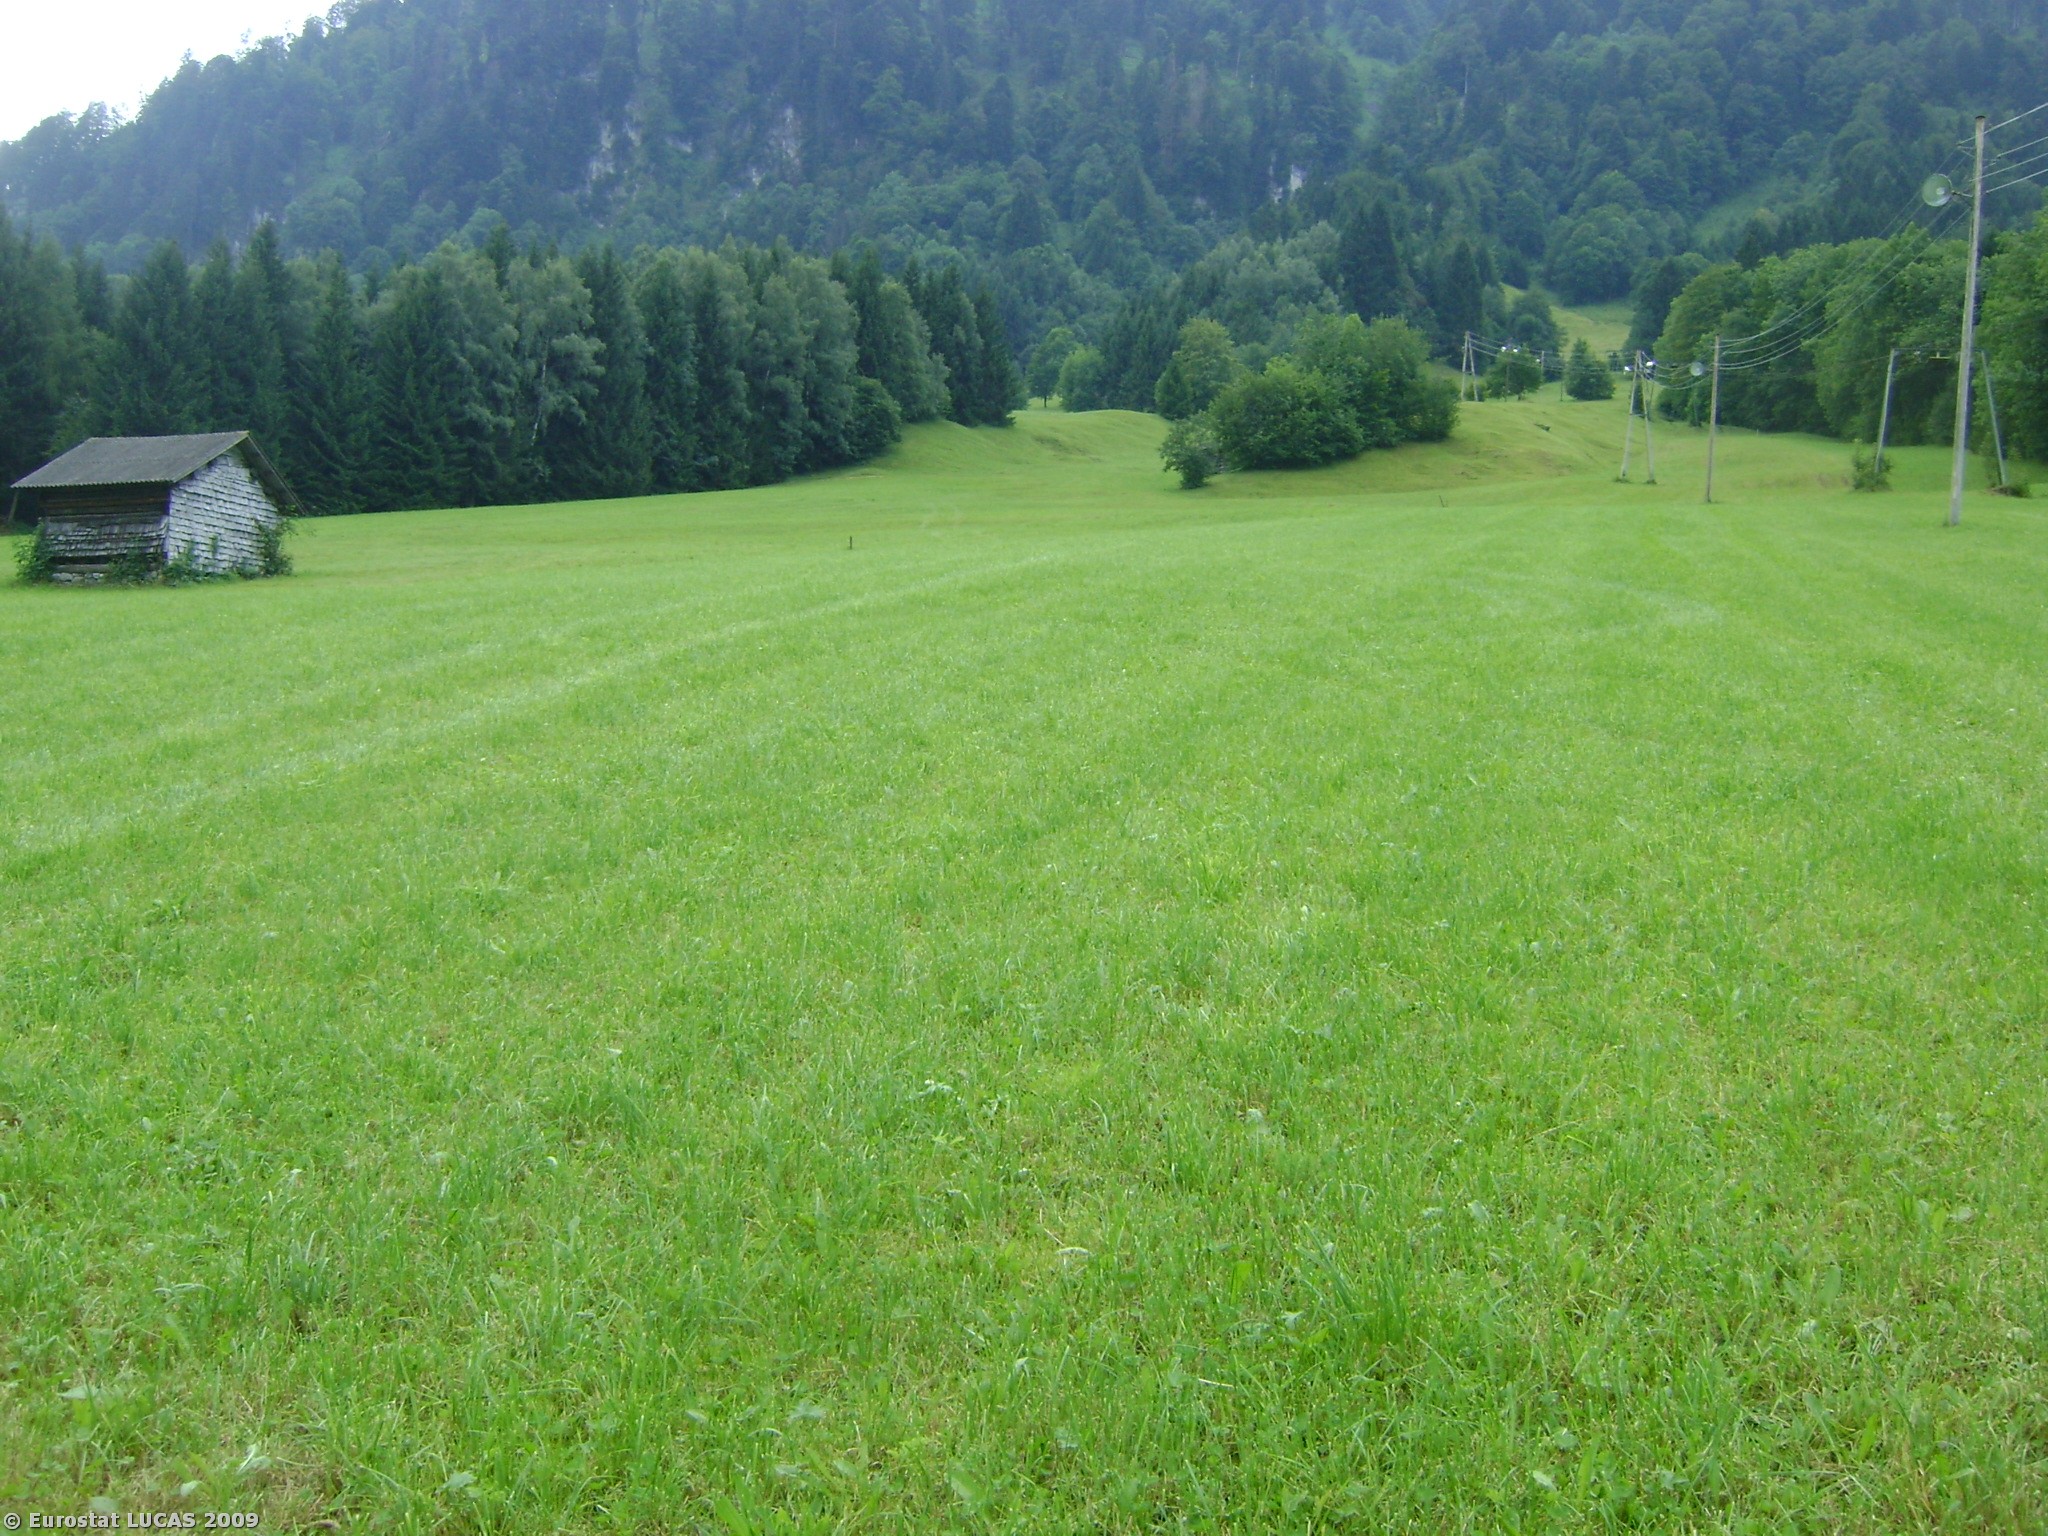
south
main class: Grassland
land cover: Grassland without tree/shrub cover
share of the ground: > 75 %
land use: Agriculture (excluding fallow land and kitchen gardens)
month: August
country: AT
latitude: 47.1791
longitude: 9.6705
